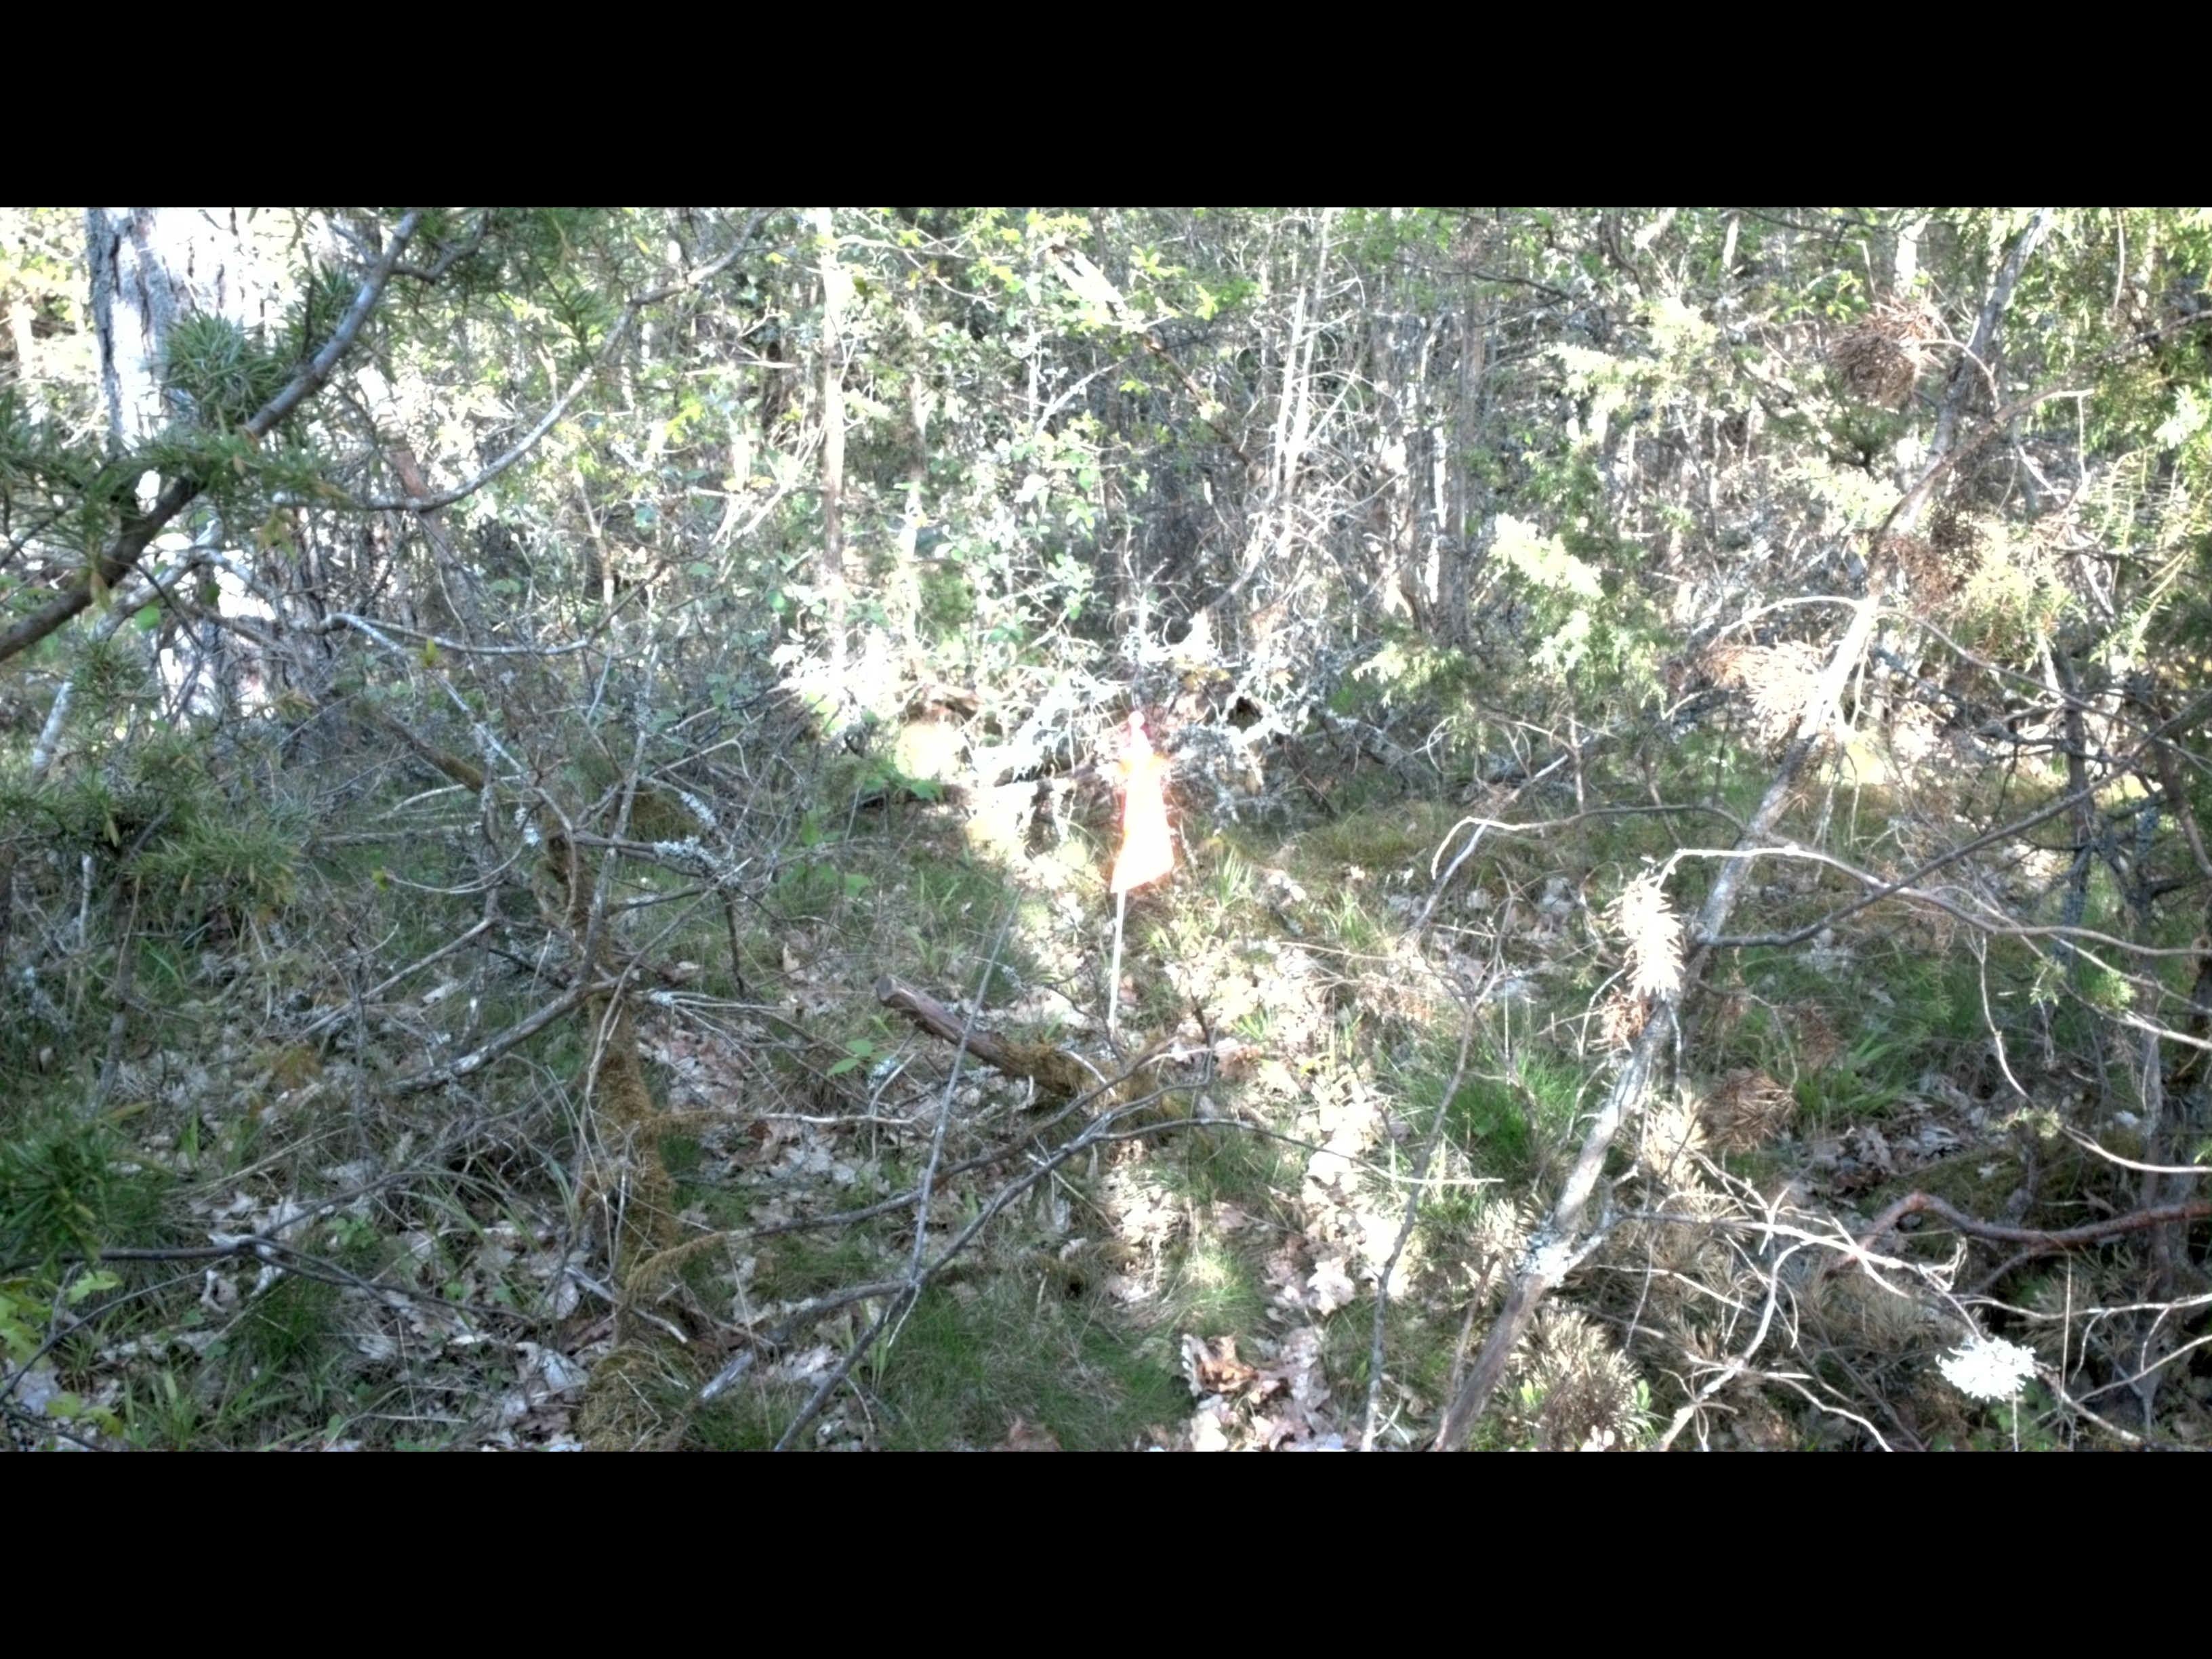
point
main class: Woodland
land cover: Pine dominated mixed woodland
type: boreal forest
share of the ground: > 75 %
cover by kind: broadleaved forest trees 60 %, coniferous forest trees 20 %, herbaceous plants 15 %, shrubs 5 %
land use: Forestry
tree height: > 5 m
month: May
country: SE
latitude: 57.3922
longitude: 16.1713
